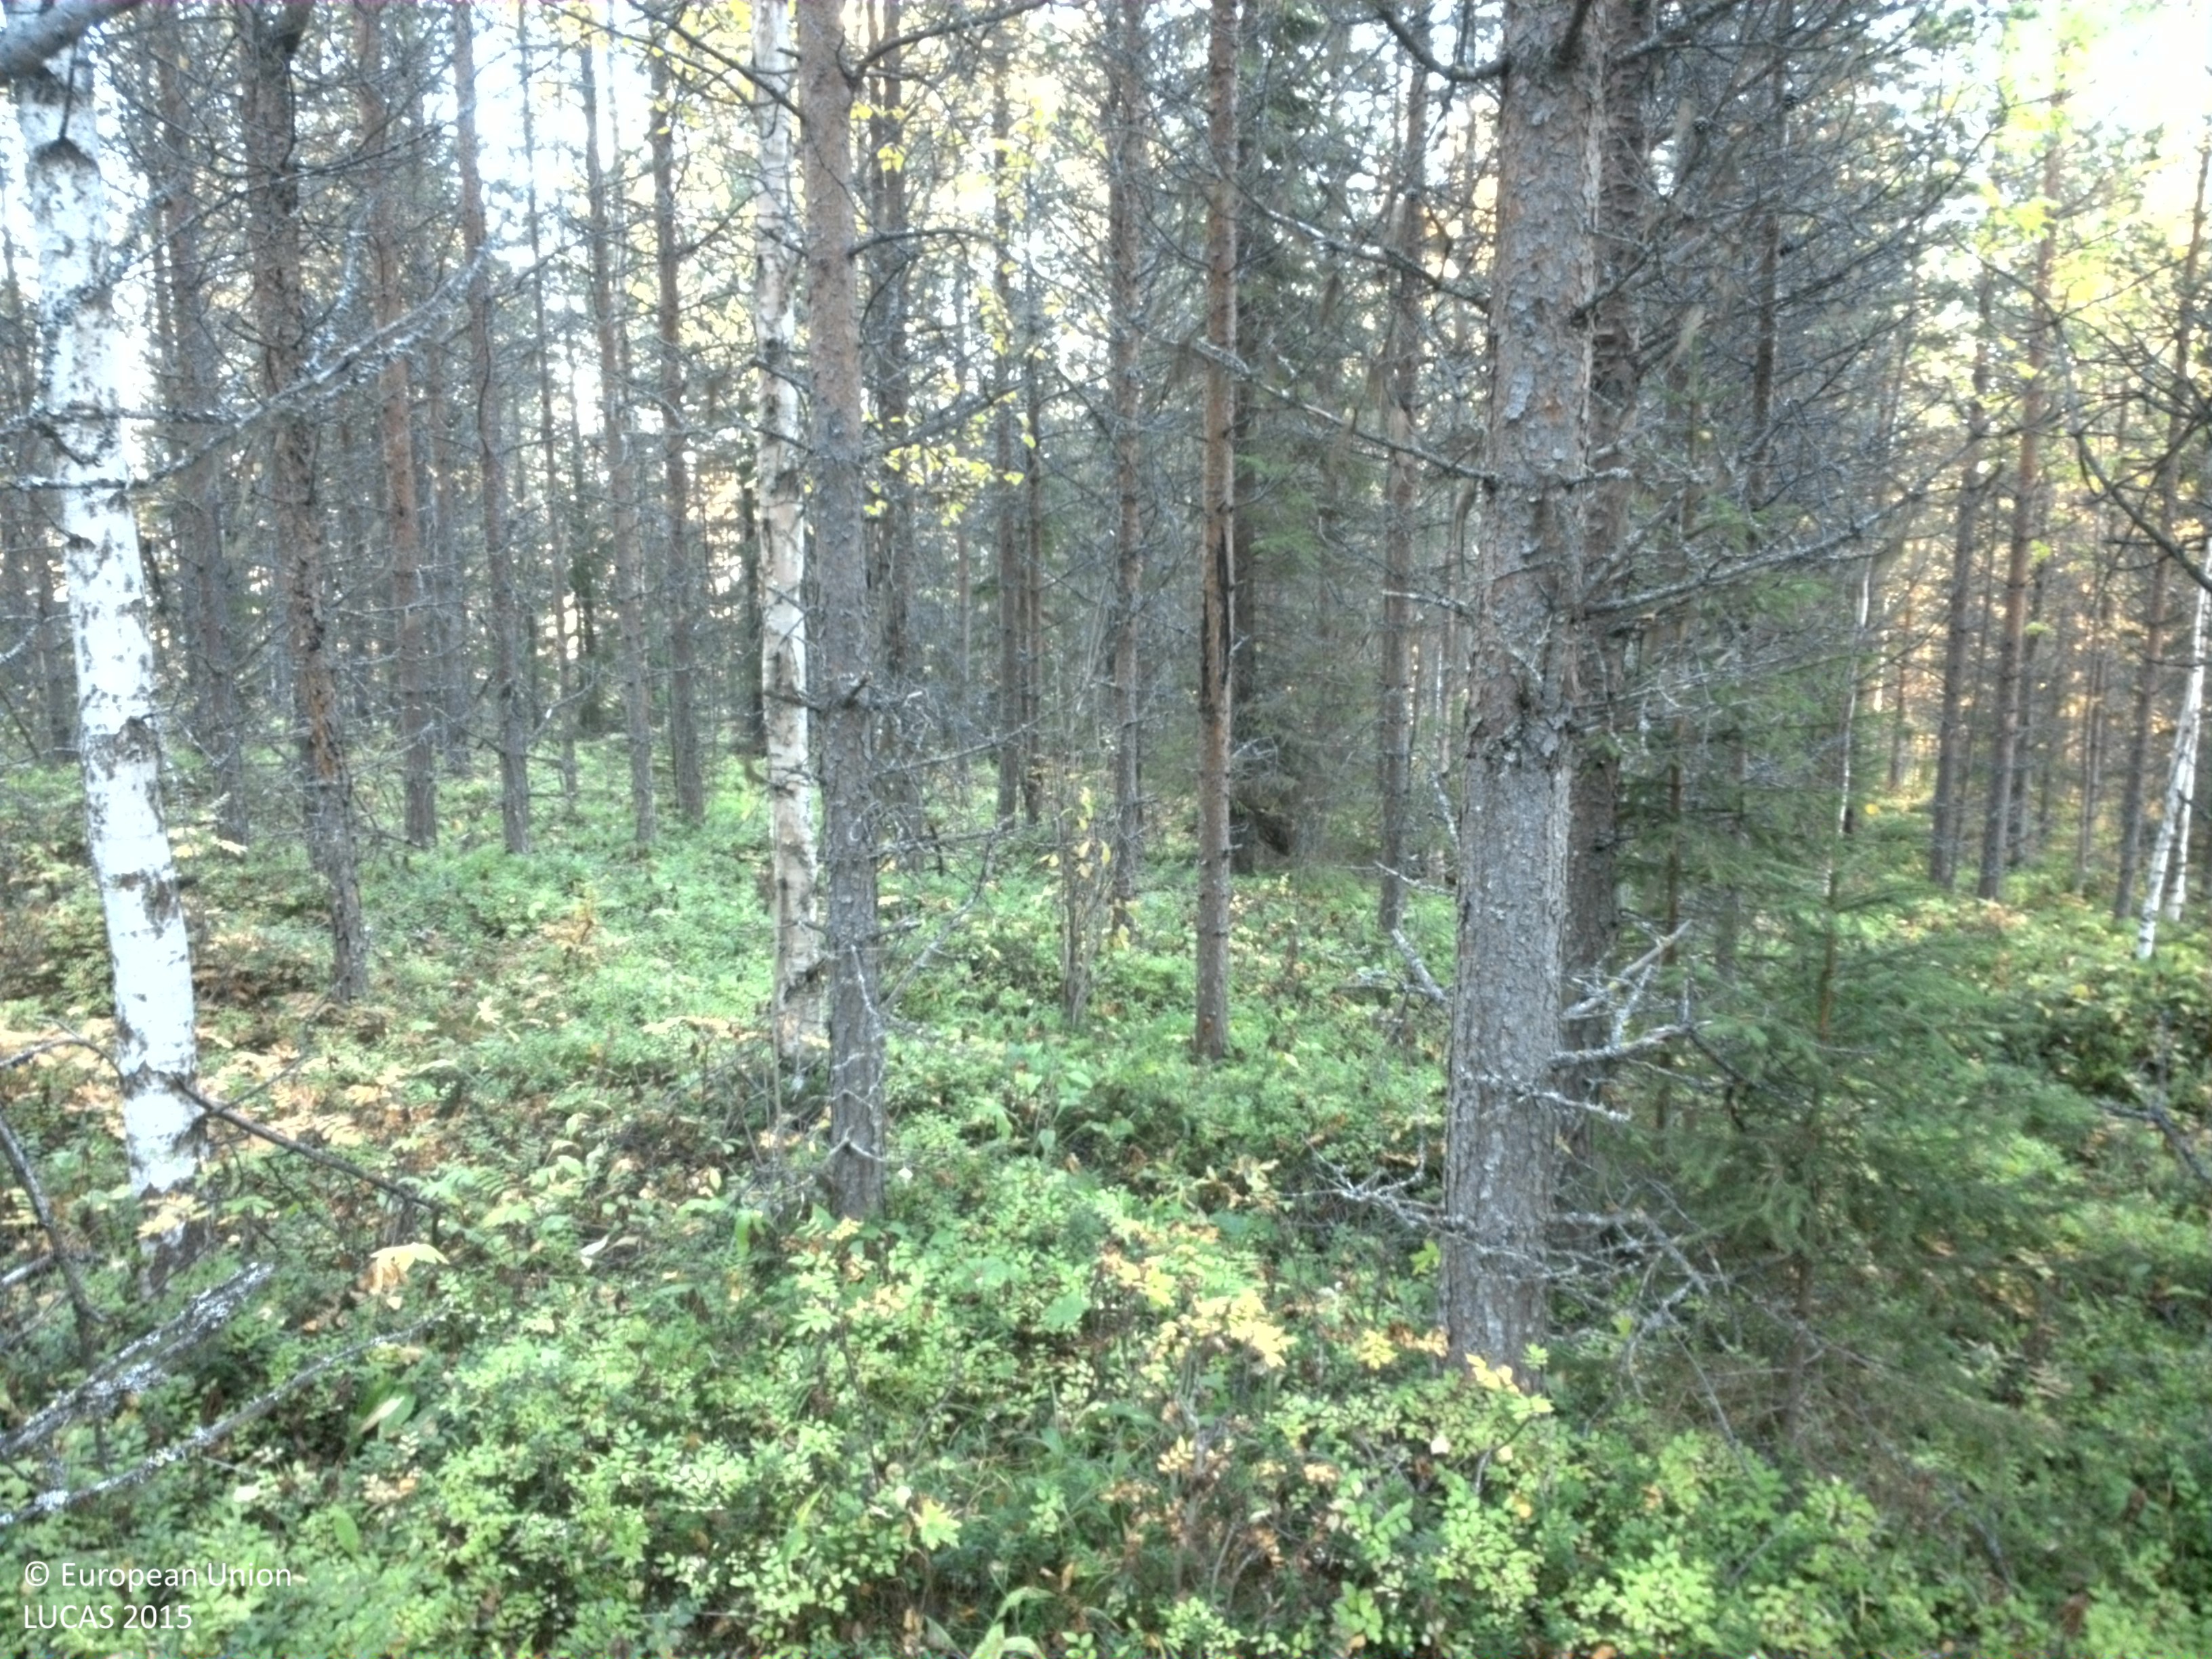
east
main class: Woodland
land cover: Pine dominated coniferous woodland
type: boreal forest
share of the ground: 50 - 75 %
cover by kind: coniferous forest trees 45 %, shrubs 35 %, broadleaved forest trees 10 %, herbaceous plants 10 %
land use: Forestry
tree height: > 5 m
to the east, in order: Pine dominated coniferous woodland; Other mixed woodland; Broadleaved woodland; Pine dominated mixed woodland; Broadleaved woodland; Electric lines; Broadleaved woodland; Other mixed woodland
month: September
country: SE
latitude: 64.9342
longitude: 17.7702
